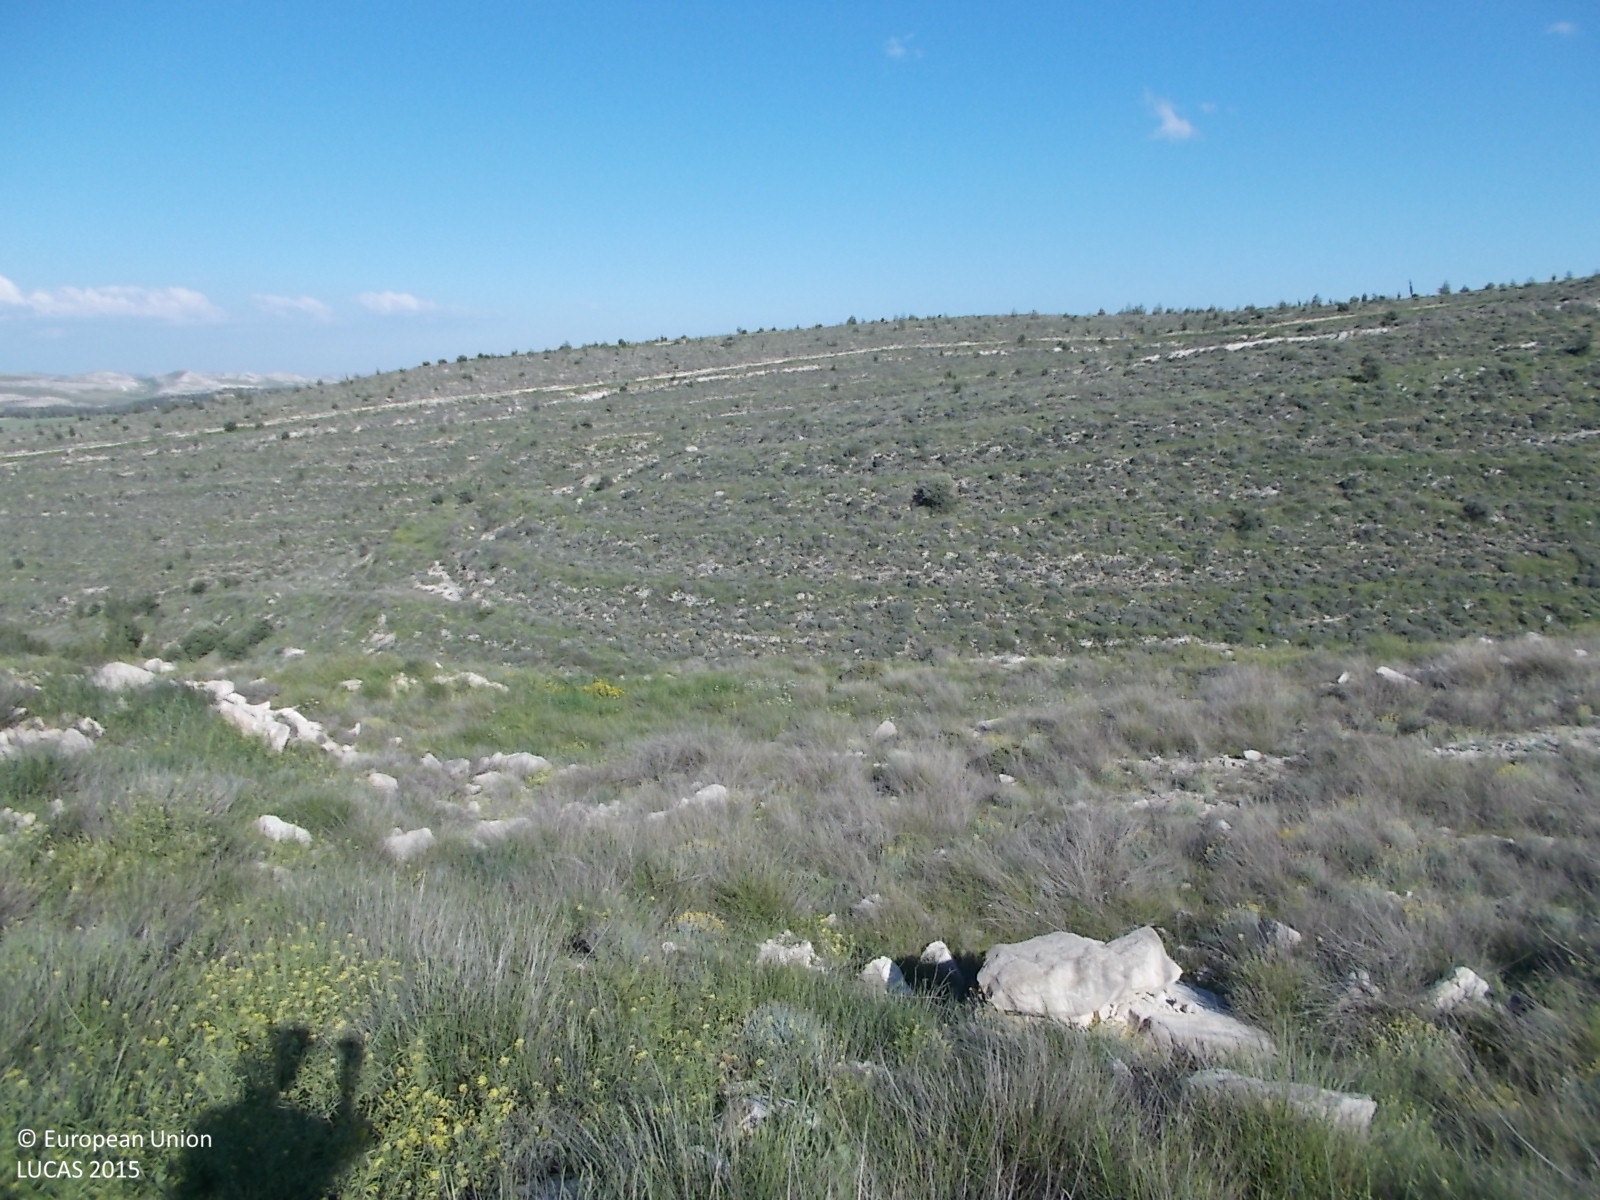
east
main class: Shrubland
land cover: Shrubland without tree cover
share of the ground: > 75 %
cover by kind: shrubs 100 %
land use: Semi-natural and natural areas not in use
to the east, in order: Shrubland without tree cover; Rock outcrops; Shrubland without tree cover; Rocks and stones; Shrubland without tree cover; Rivers and streams; Shrubland without tree cover; Rock outcrops; Rocks and stones; Shrubland with sparse tree cover; Rocks and stones; Shrubland with sparse tree cover; Grassland with sparse tree/shrub cover; Rivers and streams; Grassland with sparse tree/shrub cover
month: April
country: CY
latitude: 34.9853
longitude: 33.4941
